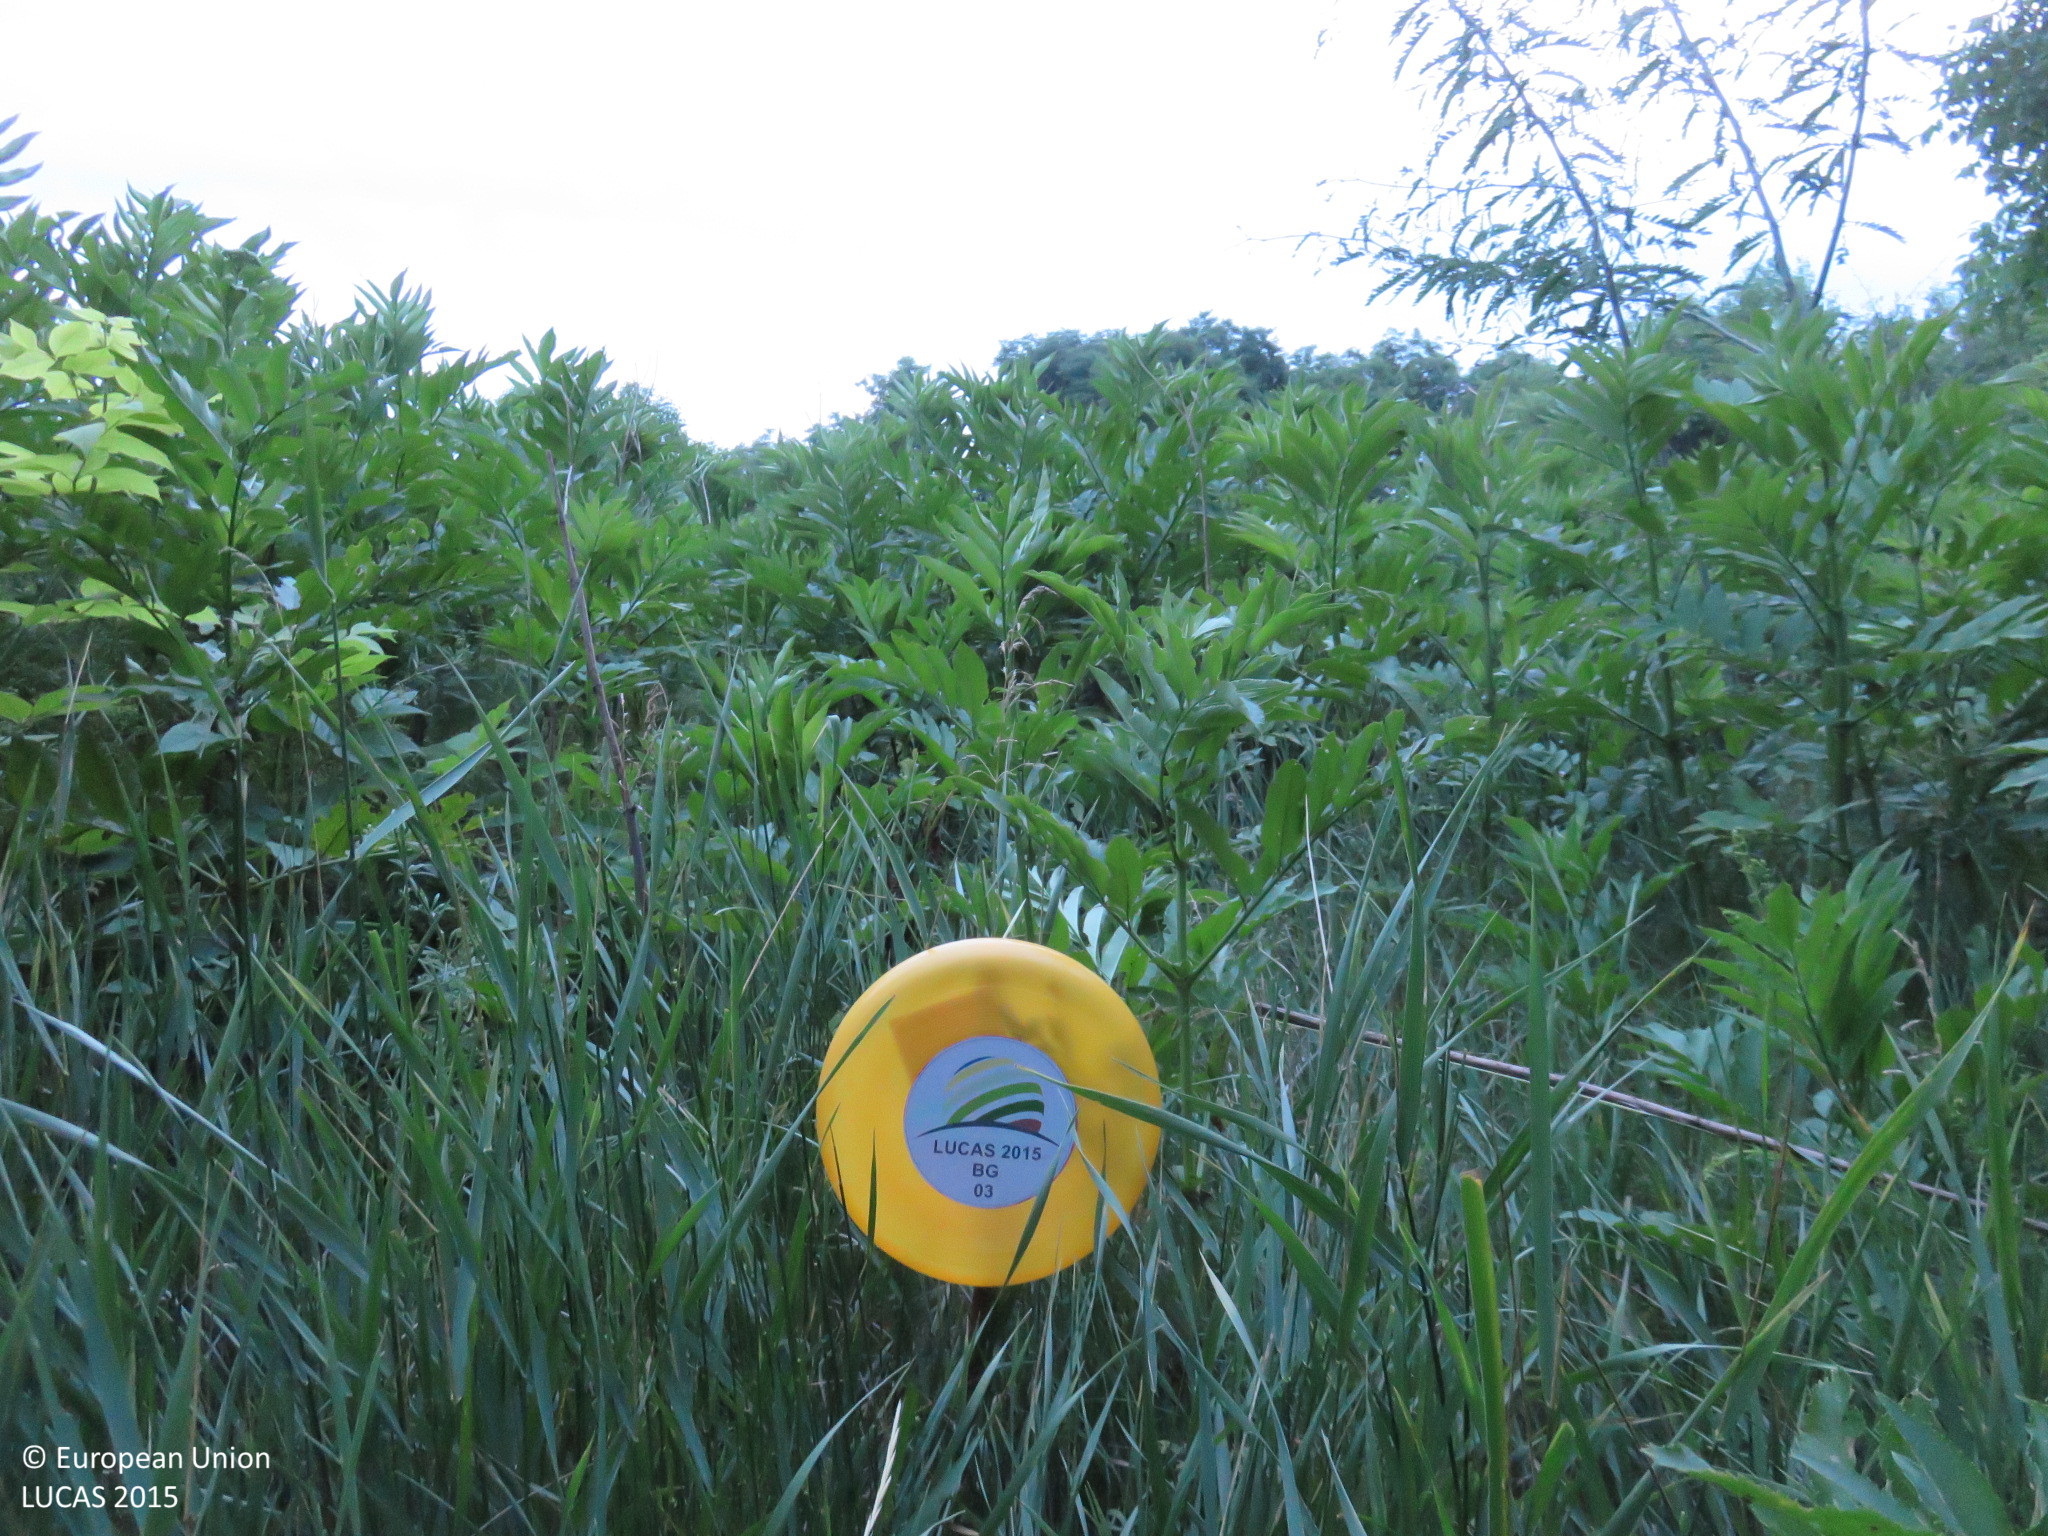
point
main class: Shrubland
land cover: Shrubland with sparse tree cover
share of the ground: > 75 %
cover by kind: shrubs 85 %, herbaceous plants 10 %, broadleaved forest trees 5 %
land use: Semi-natural and natural areas not in use
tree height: < 5 m
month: June
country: BG
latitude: 43.4670
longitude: 24.5364
